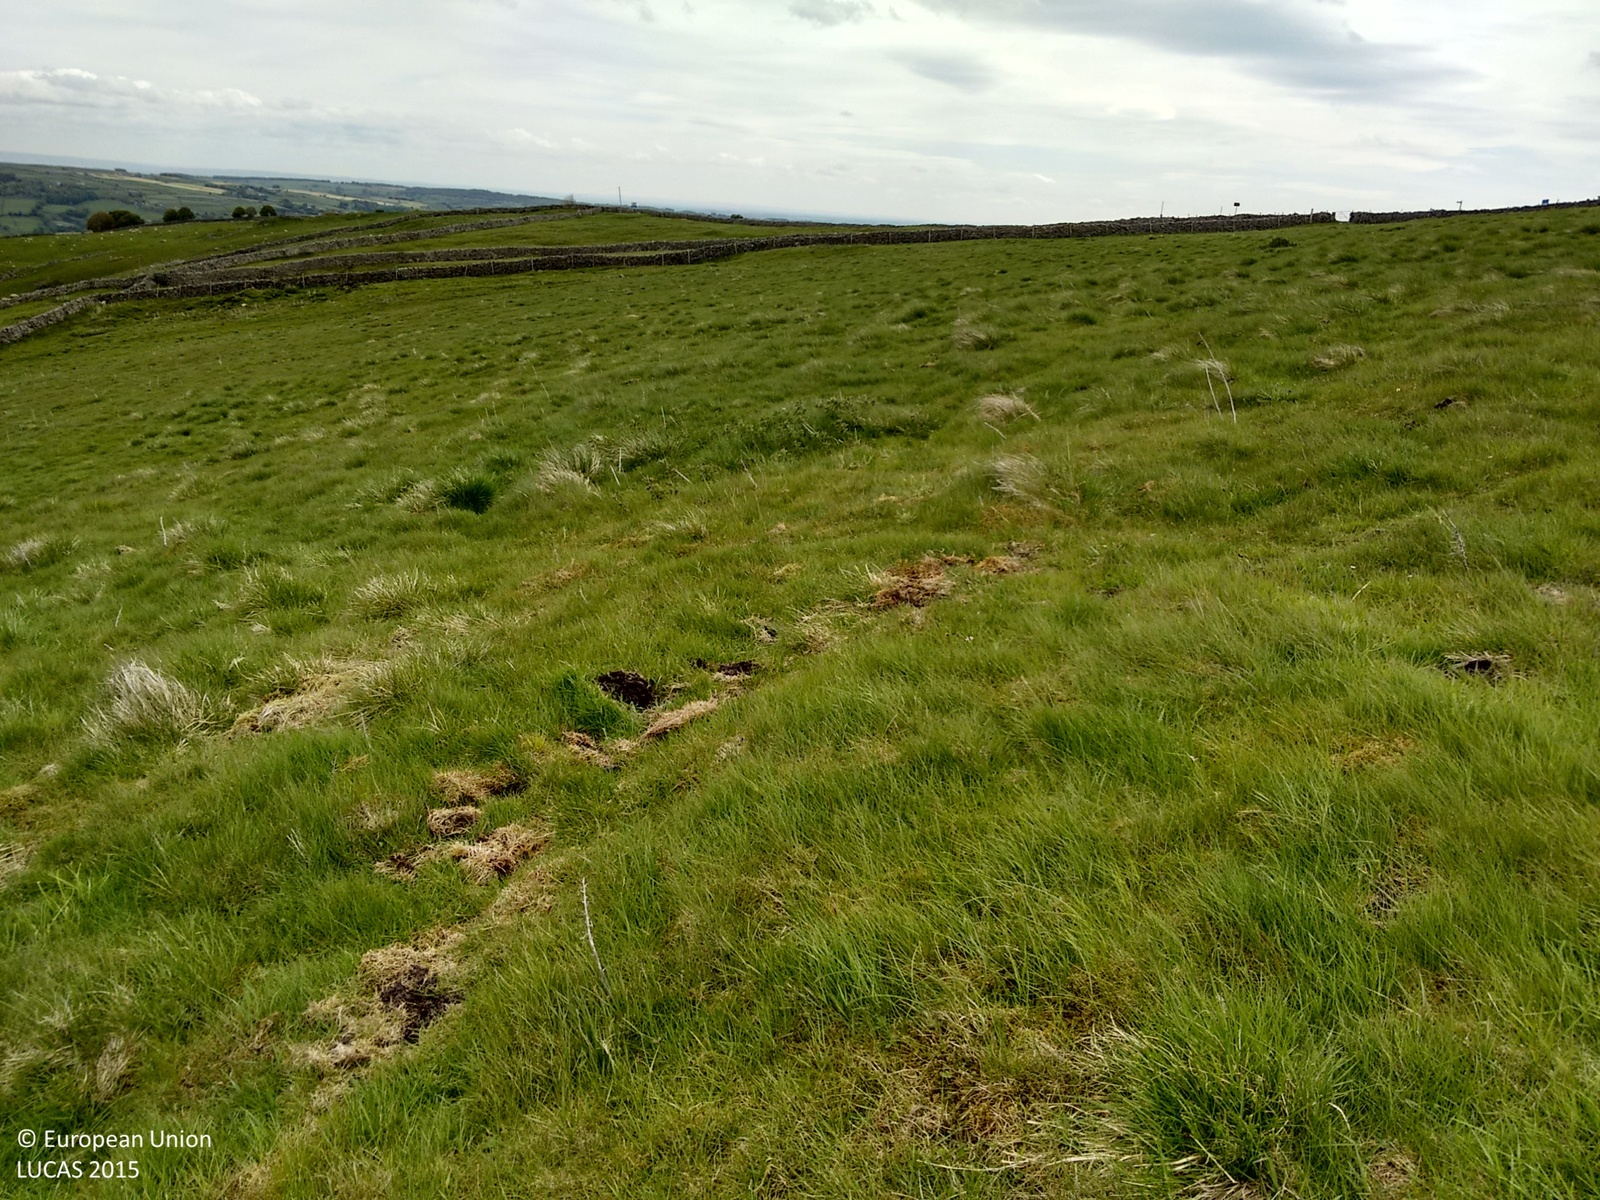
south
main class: Grassland
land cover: Grassland without tree/shrub cover
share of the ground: > 75 %
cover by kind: herbaceous plants 100 %
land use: Agriculture (excluding fallow land and kitchen gardens)
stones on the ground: < 10 %
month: June
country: GB
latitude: 54.0764
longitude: -1.8068
